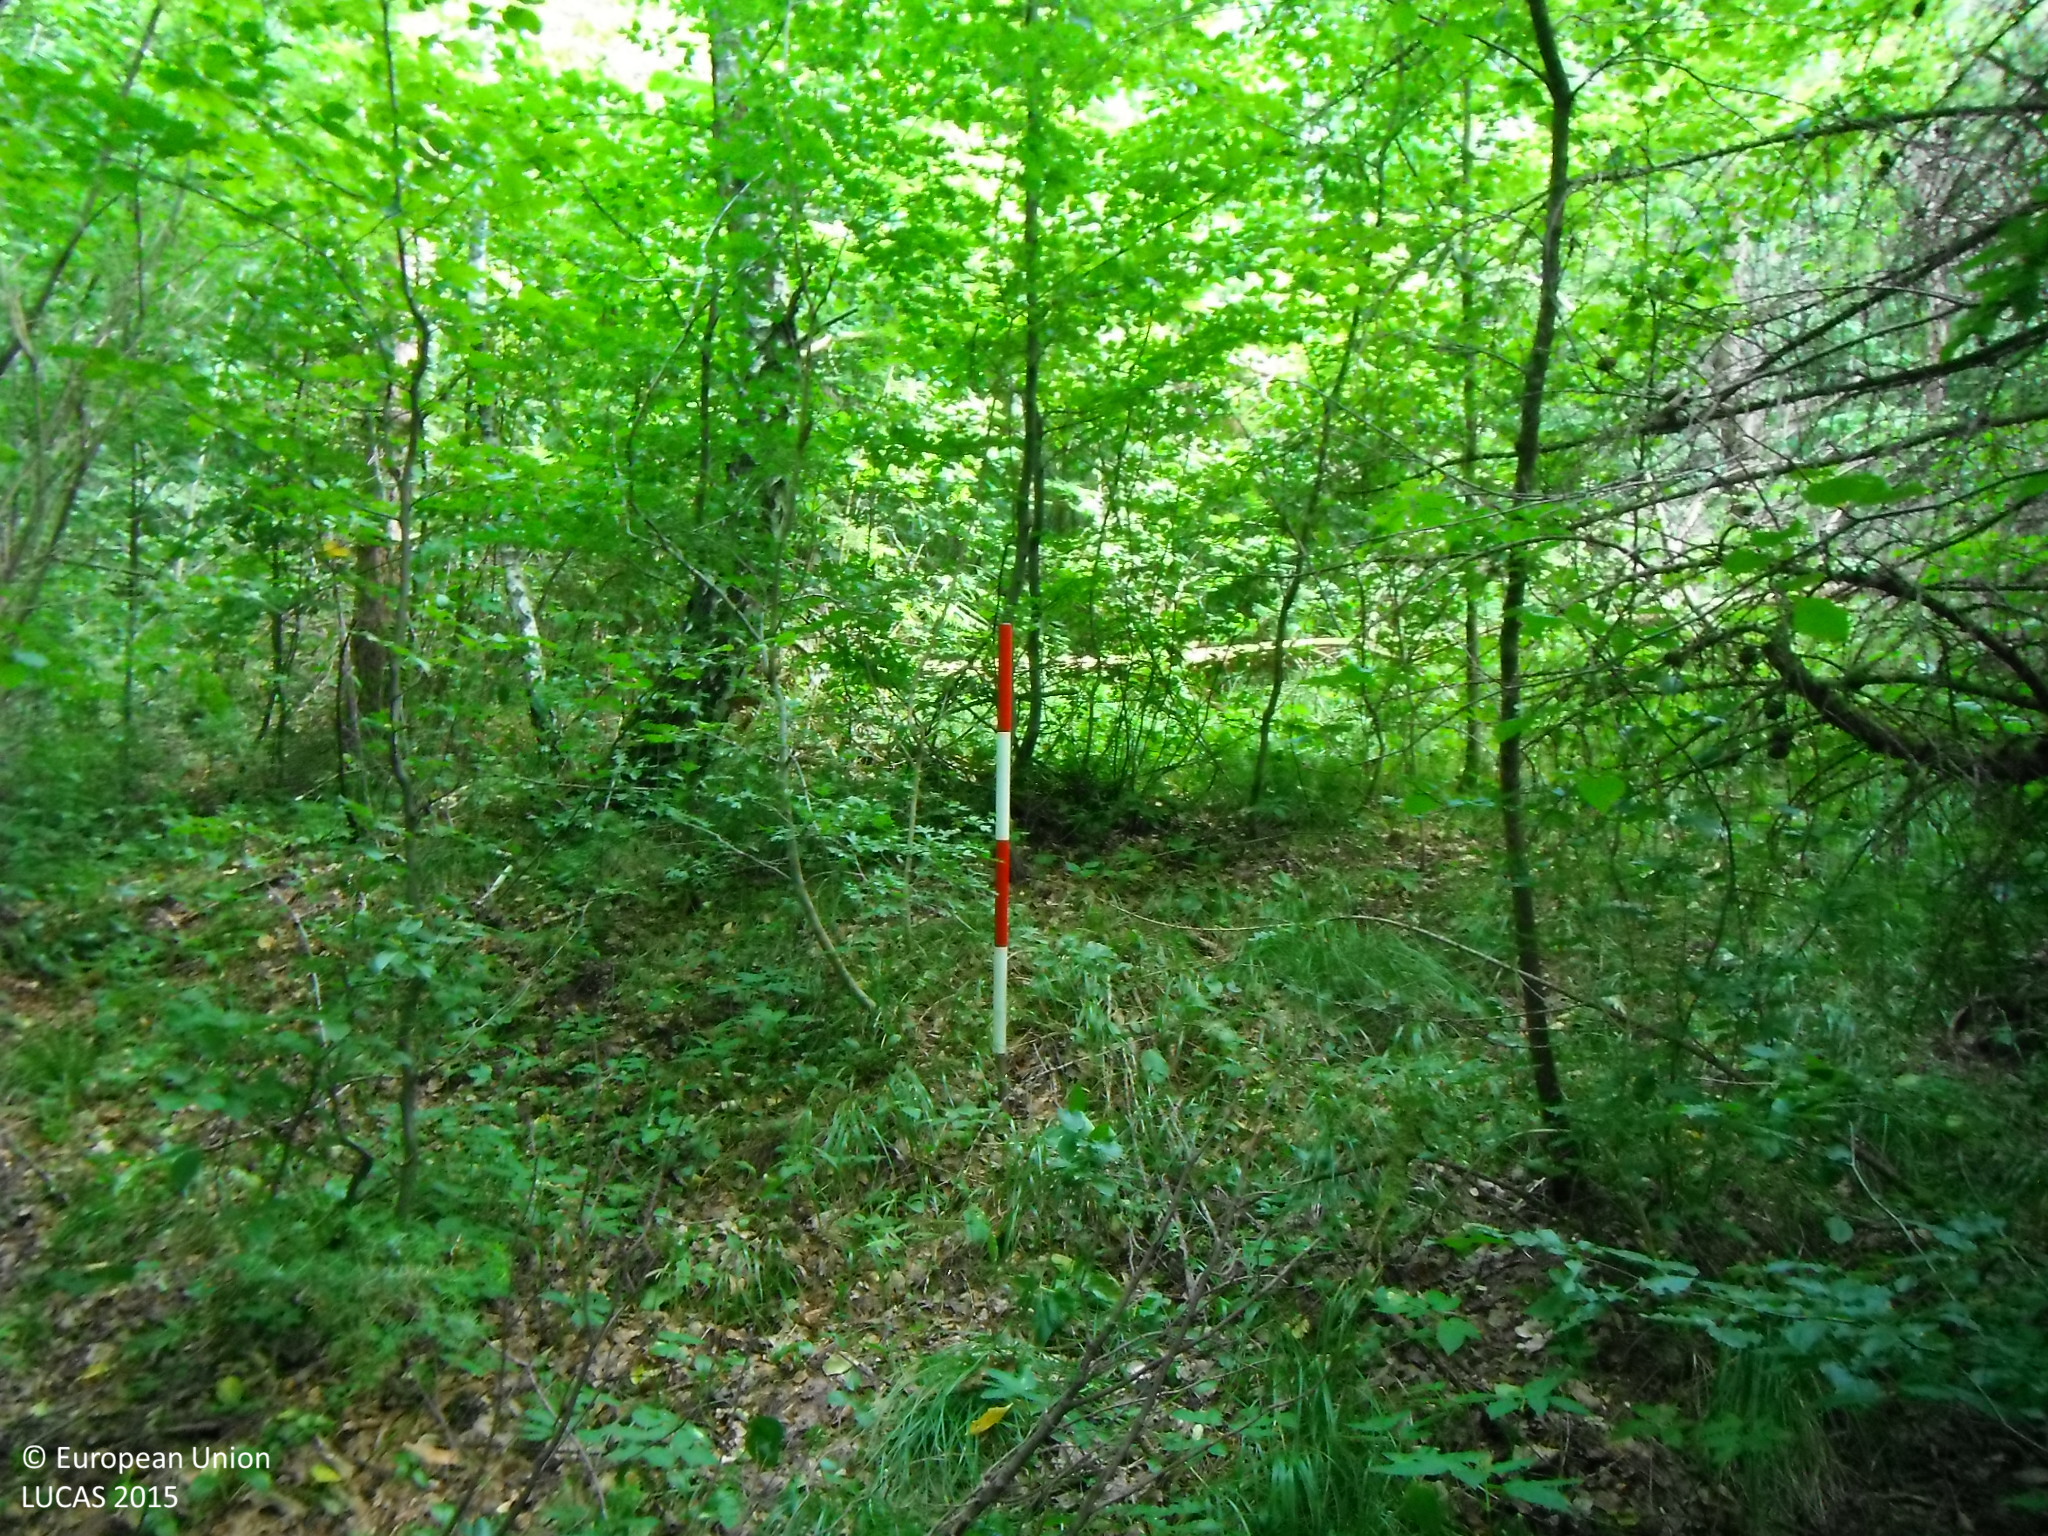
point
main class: Woodland
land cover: Broadleaved woodland
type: mesophytic deciduous forest
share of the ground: > 75 %
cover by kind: broadleaved forest trees 90 %, coniferous forest trees 10 %
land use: Forestry
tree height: > 5 m
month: July
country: SK
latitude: 49.1628
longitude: 22.0284
